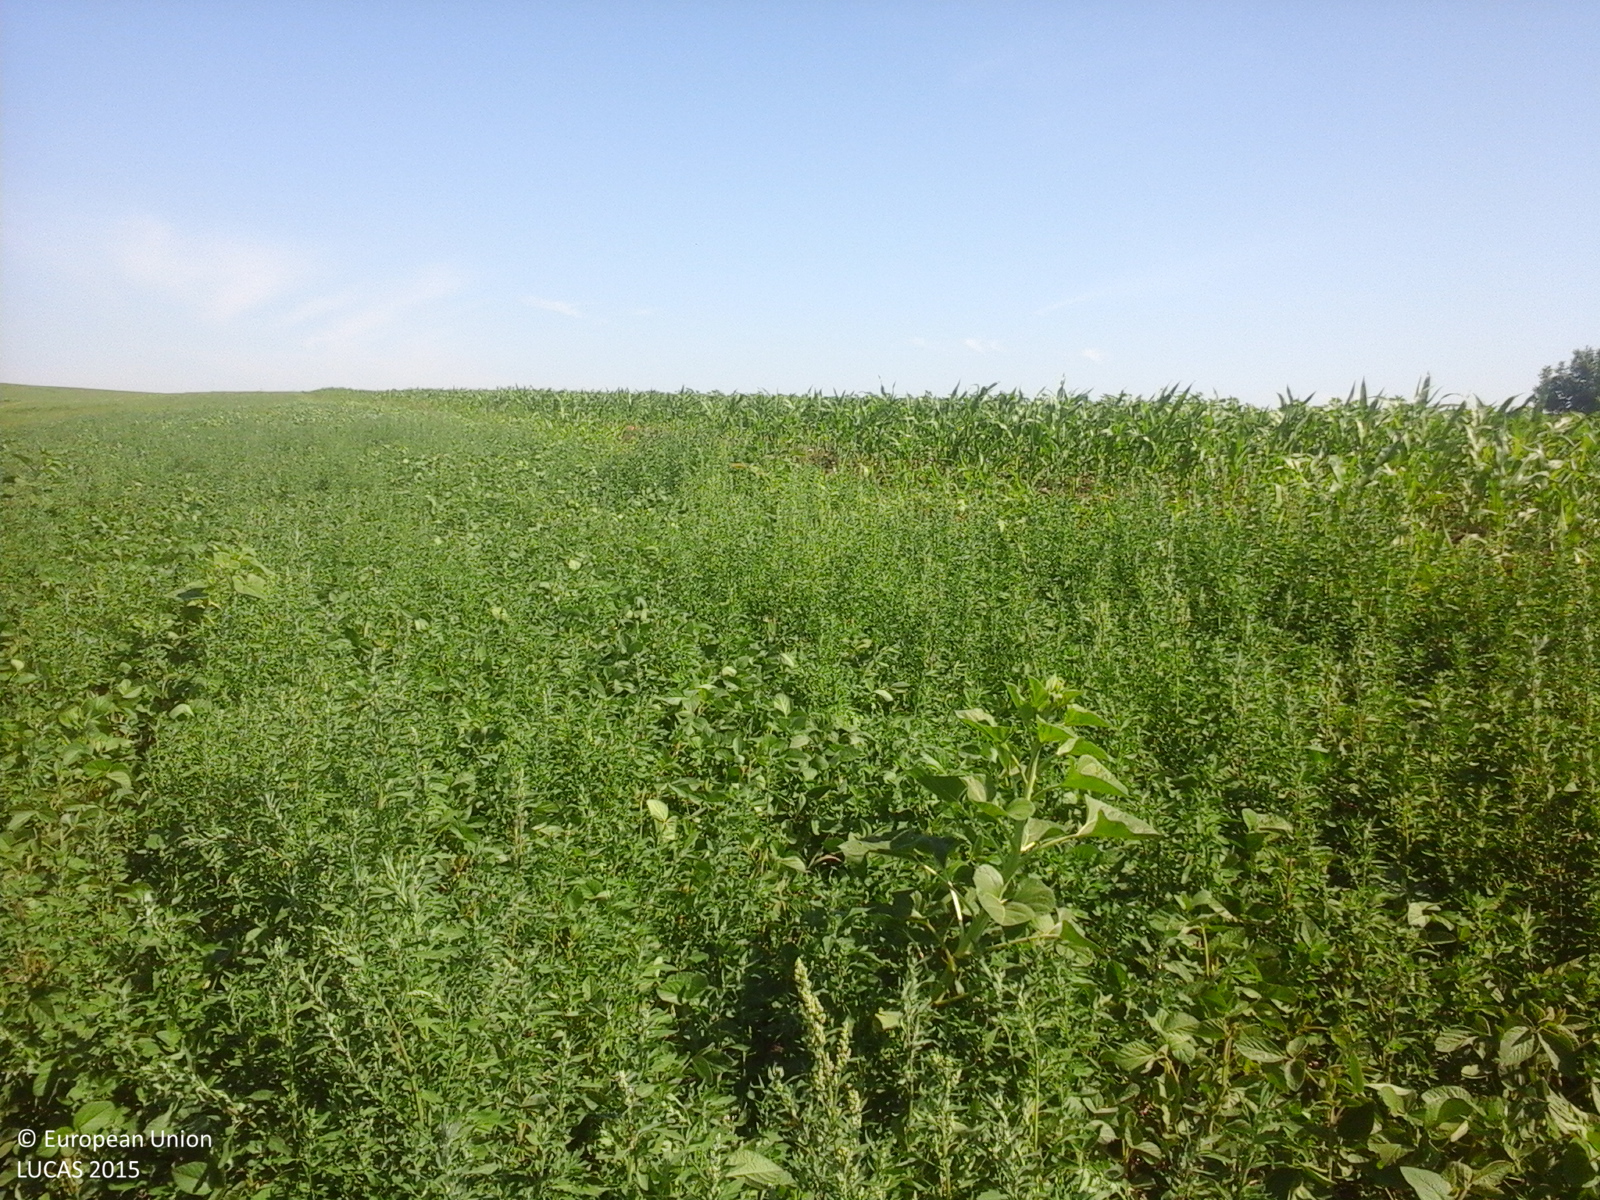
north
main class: Cropland
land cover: Soya
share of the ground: 25 - 50 %
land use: Agriculture (excluding fallow land and kitchen gardens)
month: June
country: RO
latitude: 47.7584
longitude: 27.0902
